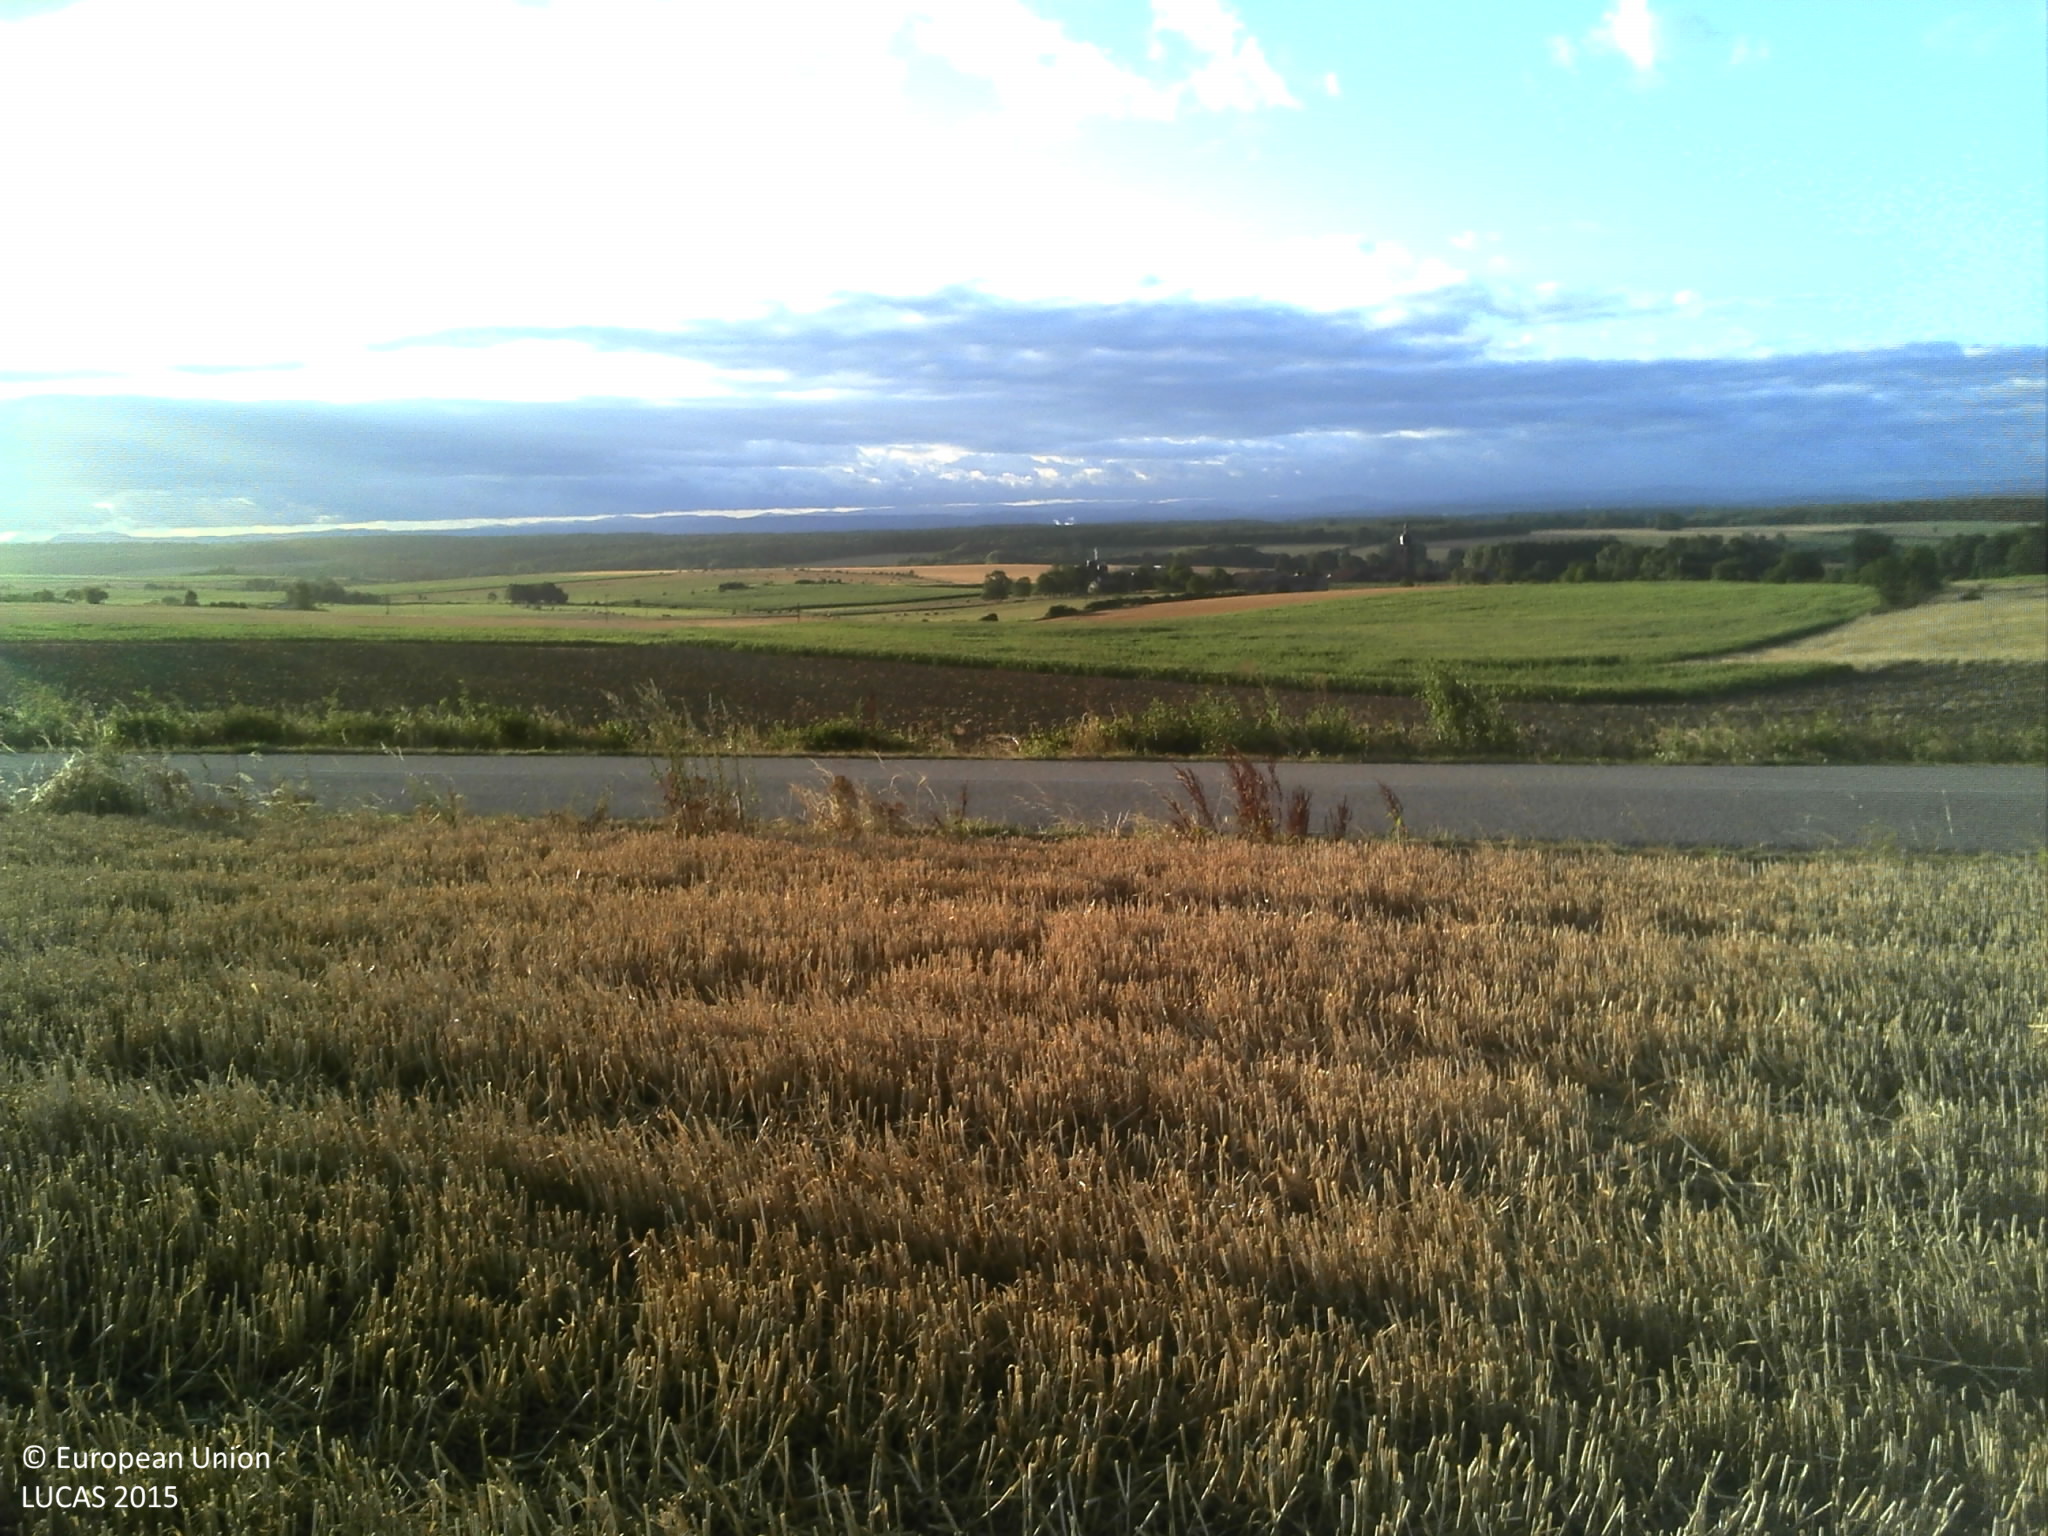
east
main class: Cropland
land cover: Durum wheat
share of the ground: < 10 %
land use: Agriculture (excluding fallow land and kitchen gardens)
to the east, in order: Durum wheat; Ditches and canals; Paved roads, cycling and walking lanes; Spontaneously vegetated surfaces; Other bare soil
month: July
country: FR
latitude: 48.2344
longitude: 6.3250
